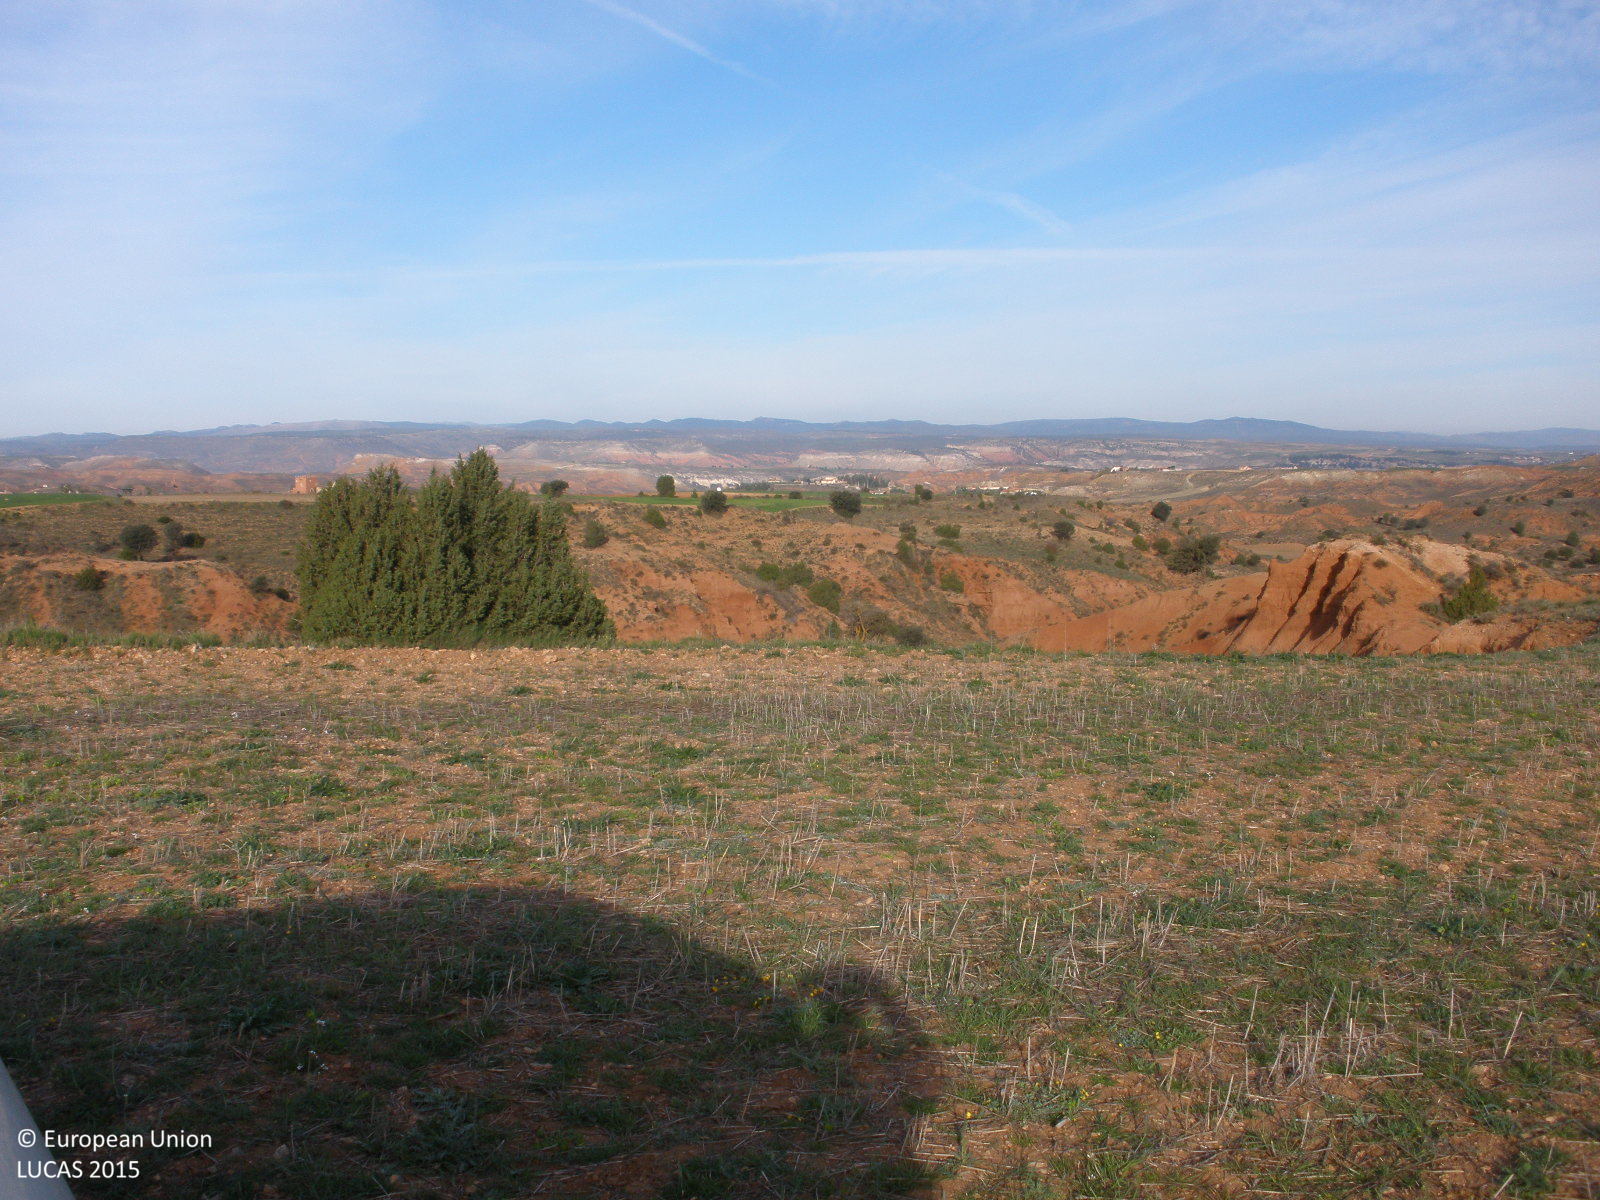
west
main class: Grassland
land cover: Spontaneously vegetated surfaces
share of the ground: > 75 %
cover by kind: herbaceous plants 85 %, unconsolidated bare surface 15 %
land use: Agriculture (excluding fallow land and kitchen gardens)
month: April
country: ES
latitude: 40.3150
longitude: -1.0597
